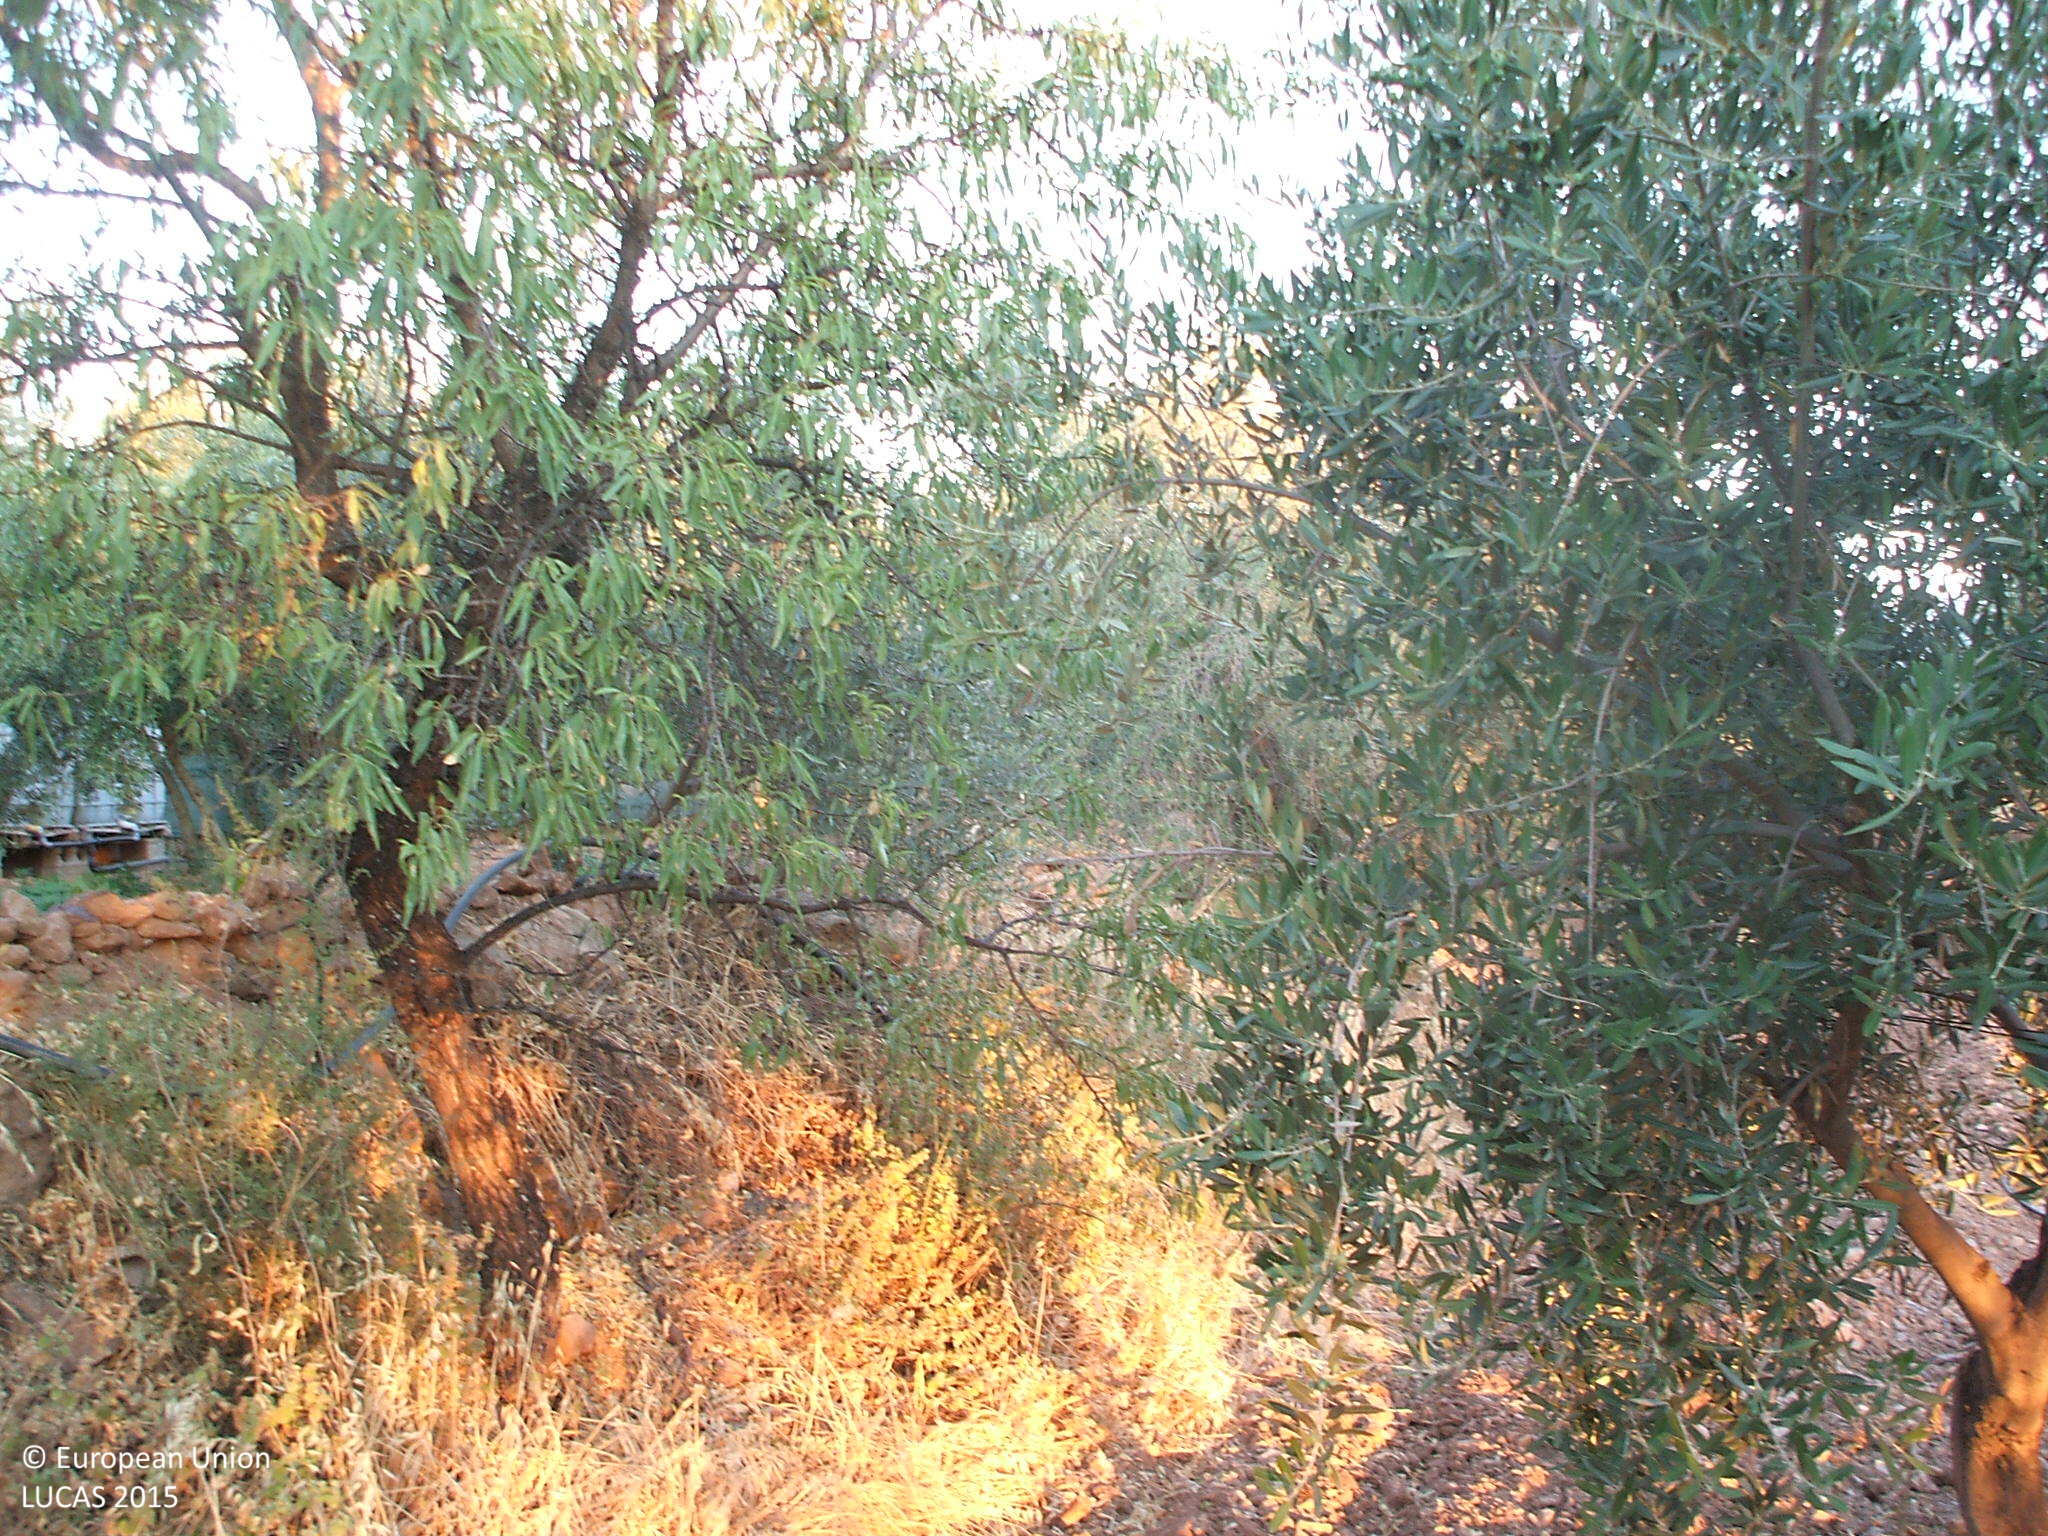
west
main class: Cropland
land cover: Olive groves
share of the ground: 25 - 50 %
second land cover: Other bare soil
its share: > 75 %
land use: Agriculture (excluding fallow land and kitchen gardens)
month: July
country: ES
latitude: 36.9797
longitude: -2.8654
